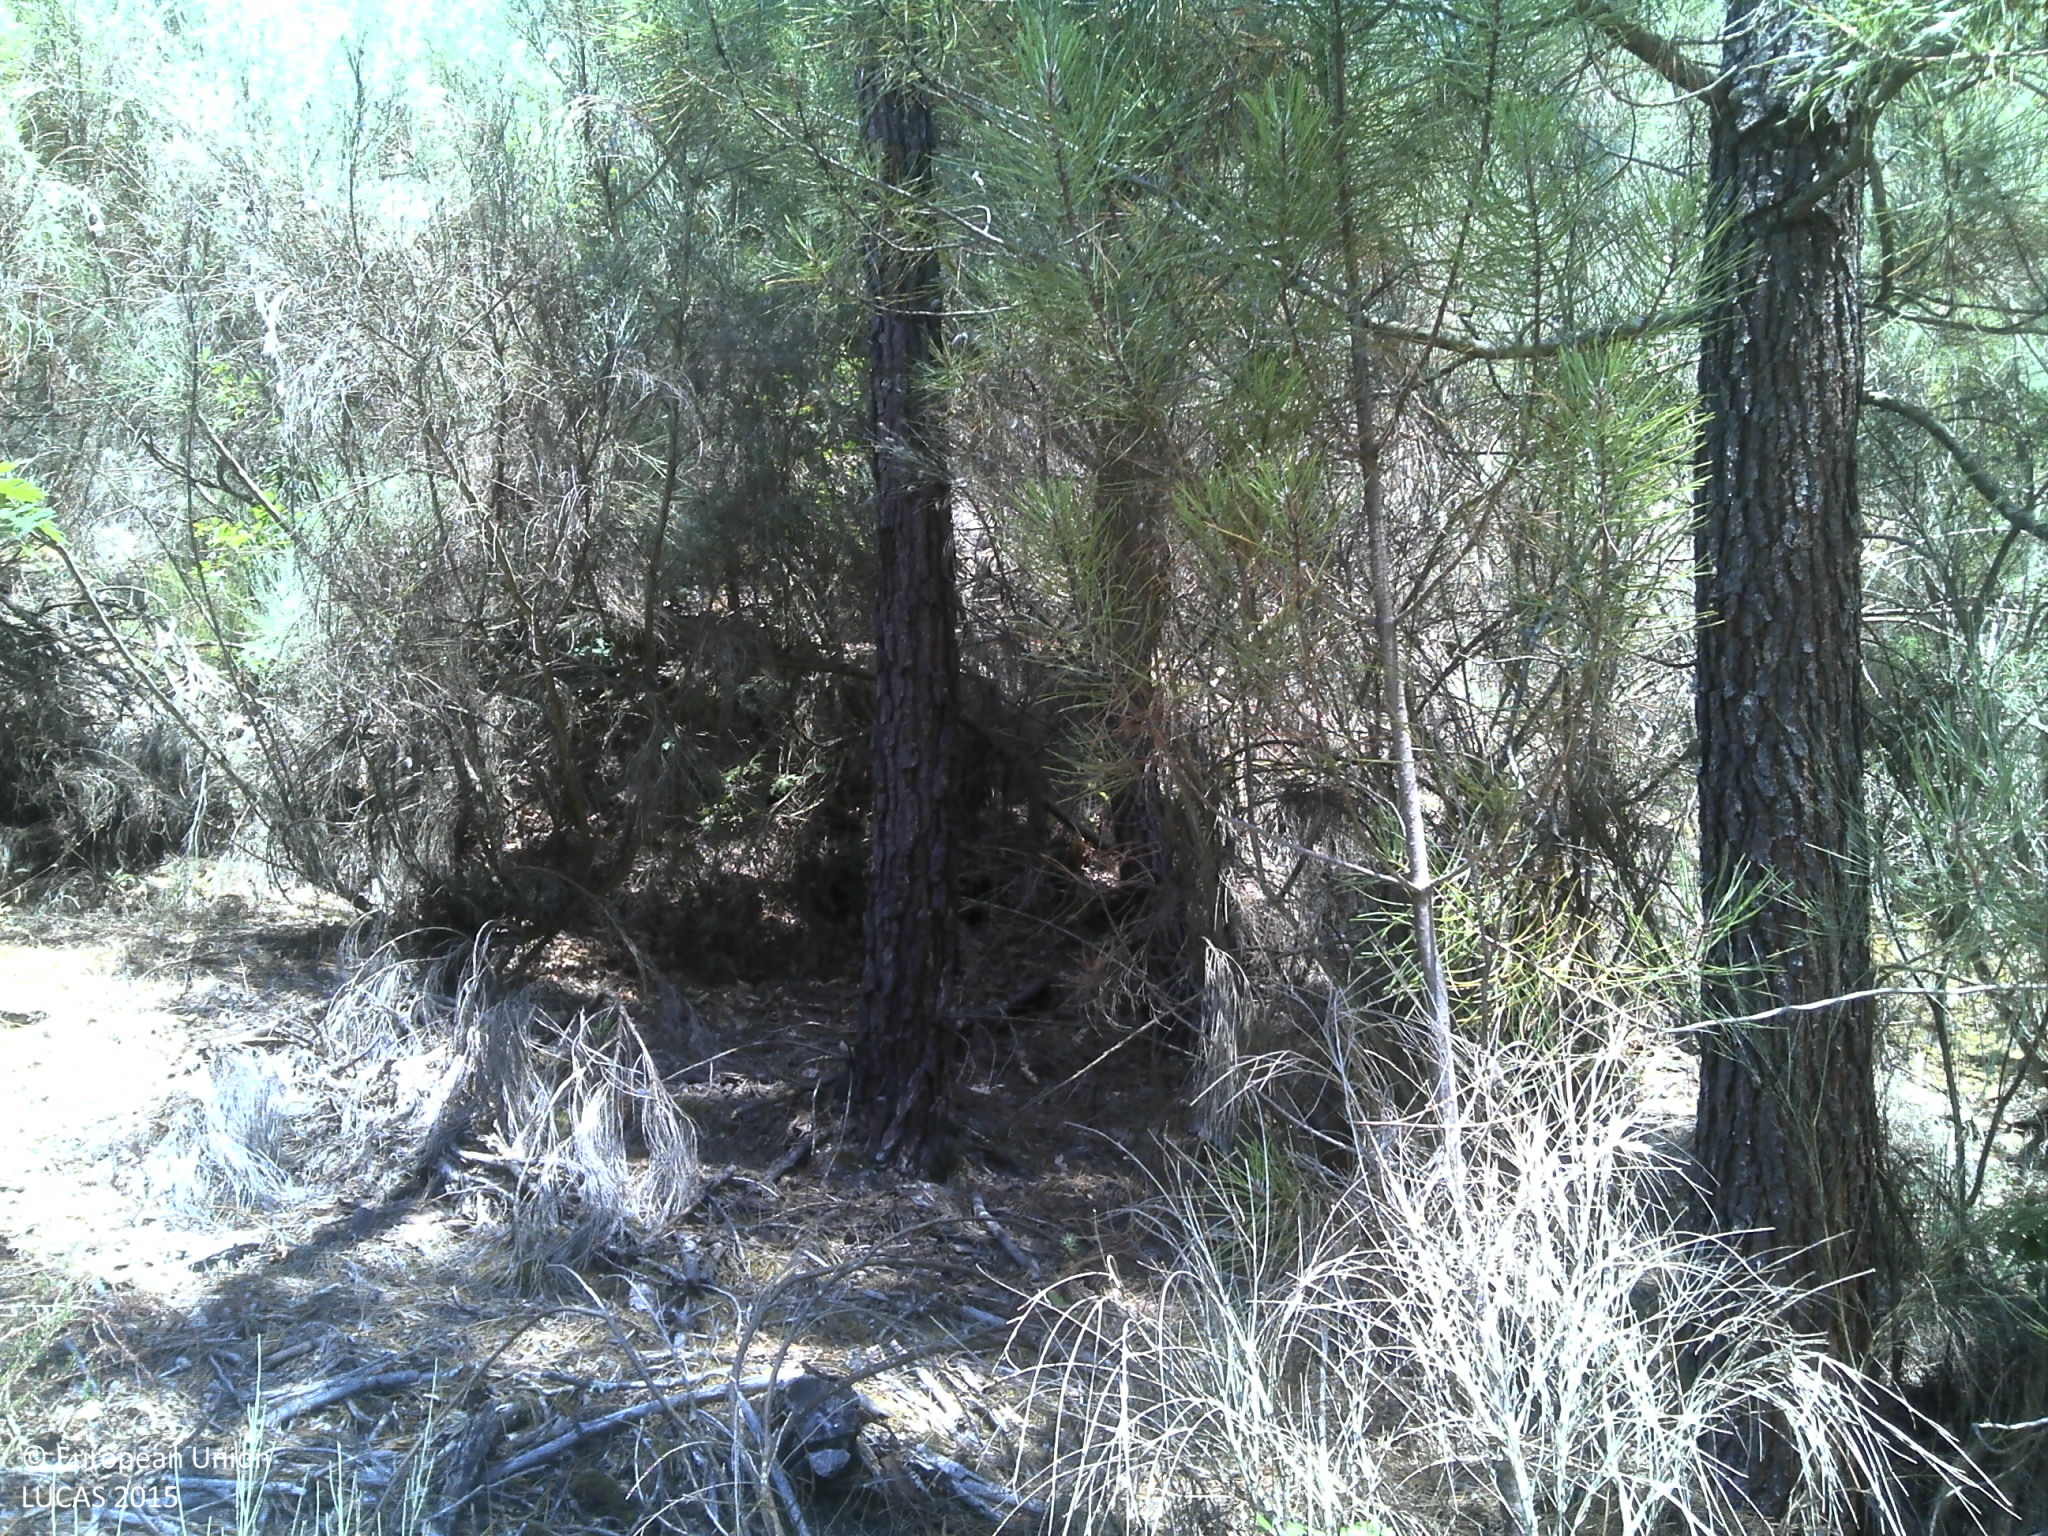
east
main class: Shrubland
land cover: Shrubland with sparse tree cover
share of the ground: 50 - 75 %
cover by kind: shrubs 75 %, unconsolidated bare surface 20 %, coniferous forest trees 5 %
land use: Abandoned areas
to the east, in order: Shrubland with sparse tree cover; Pine dominated coniferous woodland; Shrubland with sparse tree cover
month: July
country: PT
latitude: 40.3751
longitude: -7.7226
